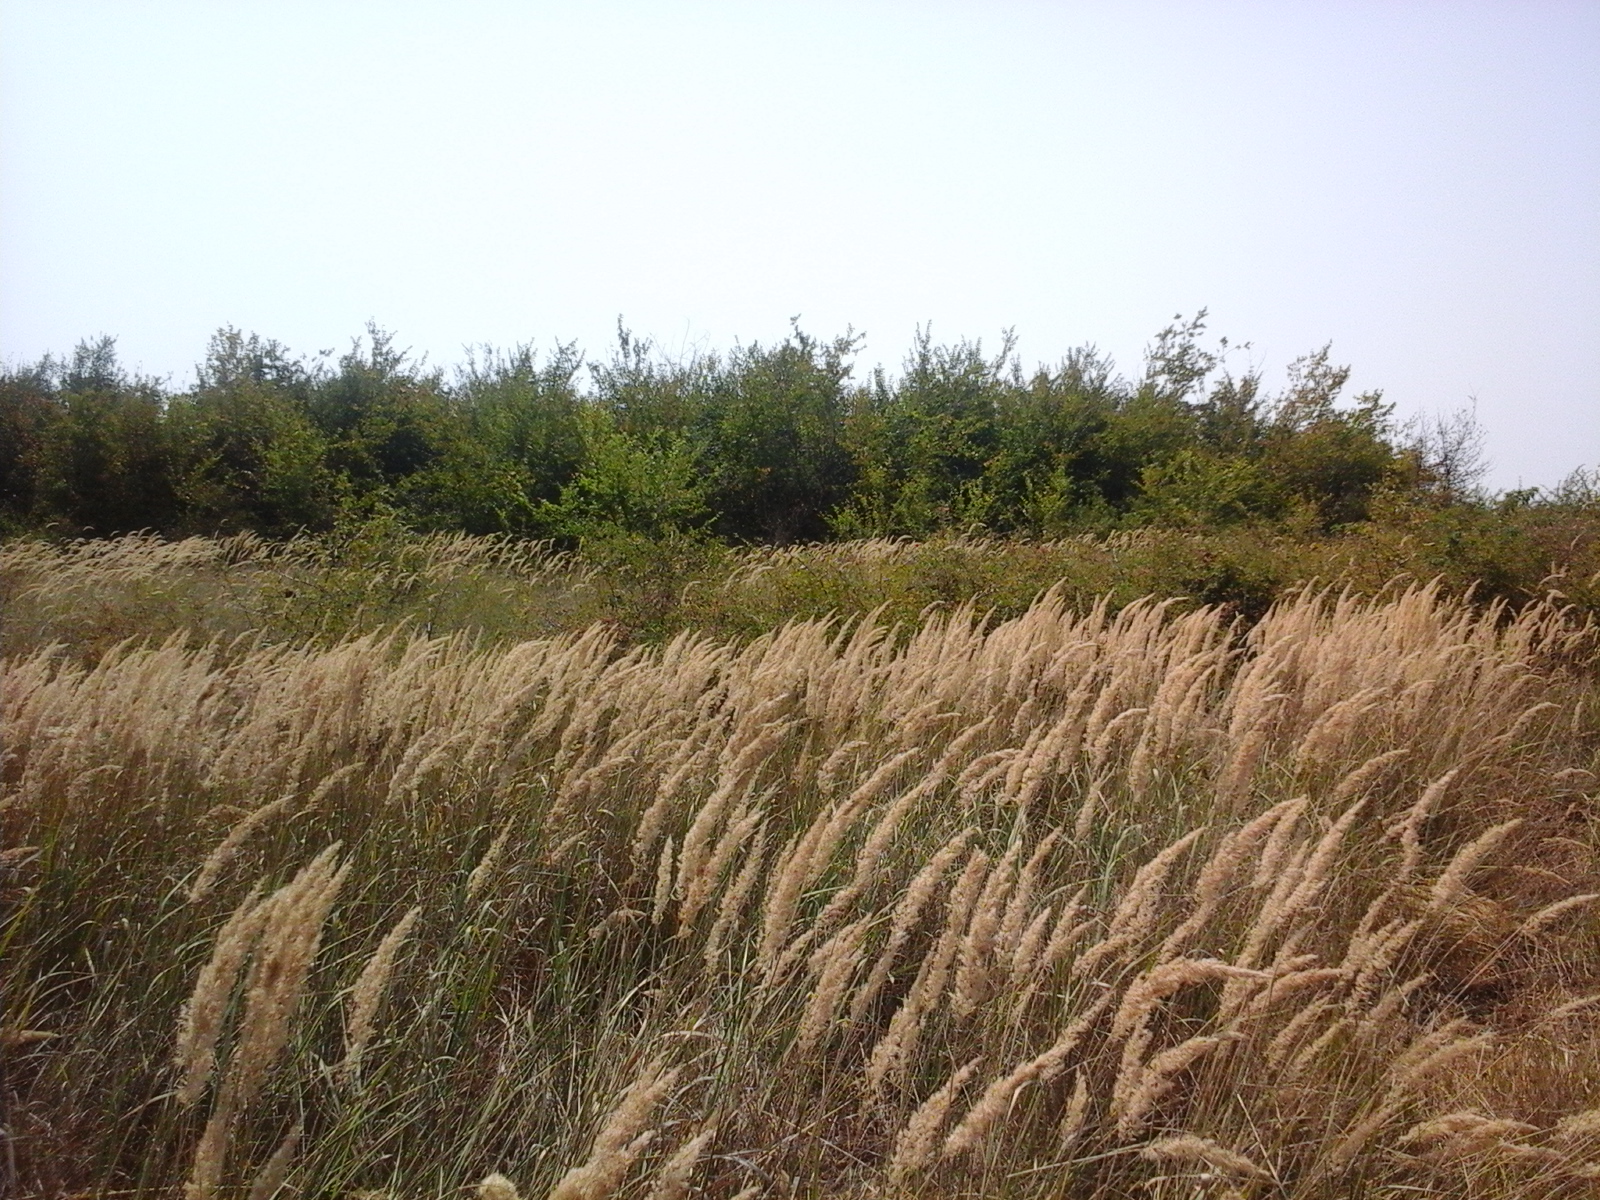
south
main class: Shrubland
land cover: Shrubland with sparse tree cover
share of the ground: > 75 %
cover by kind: shrubs 95 %, broadleaved forest trees 5 %
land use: Semi-natural and natural areas not in use
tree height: < 5 m
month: August
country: RO
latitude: 44.5042
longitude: 23.7805
